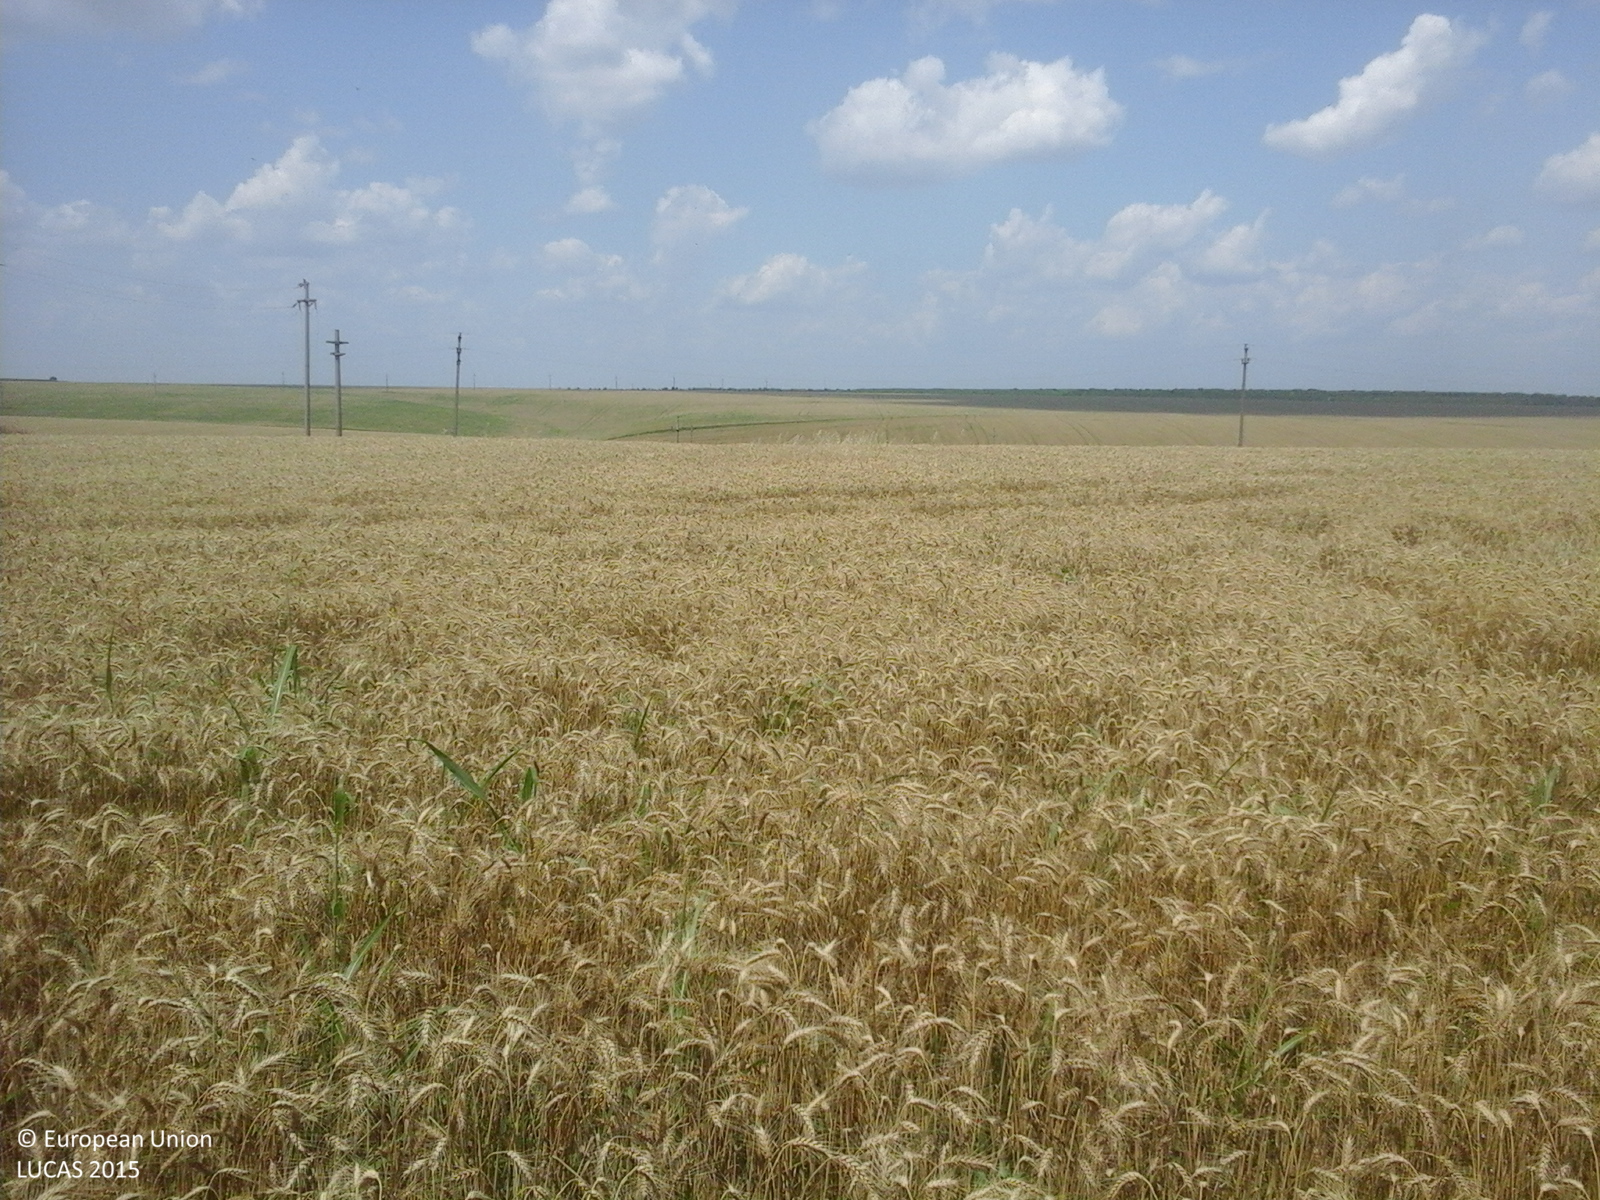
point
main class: Cropland
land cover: Common wheat
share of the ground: > 75 %
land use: Agriculture (excluding fallow land and kitchen gardens)
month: July
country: RO
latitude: 43.8714
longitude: 25.7583
